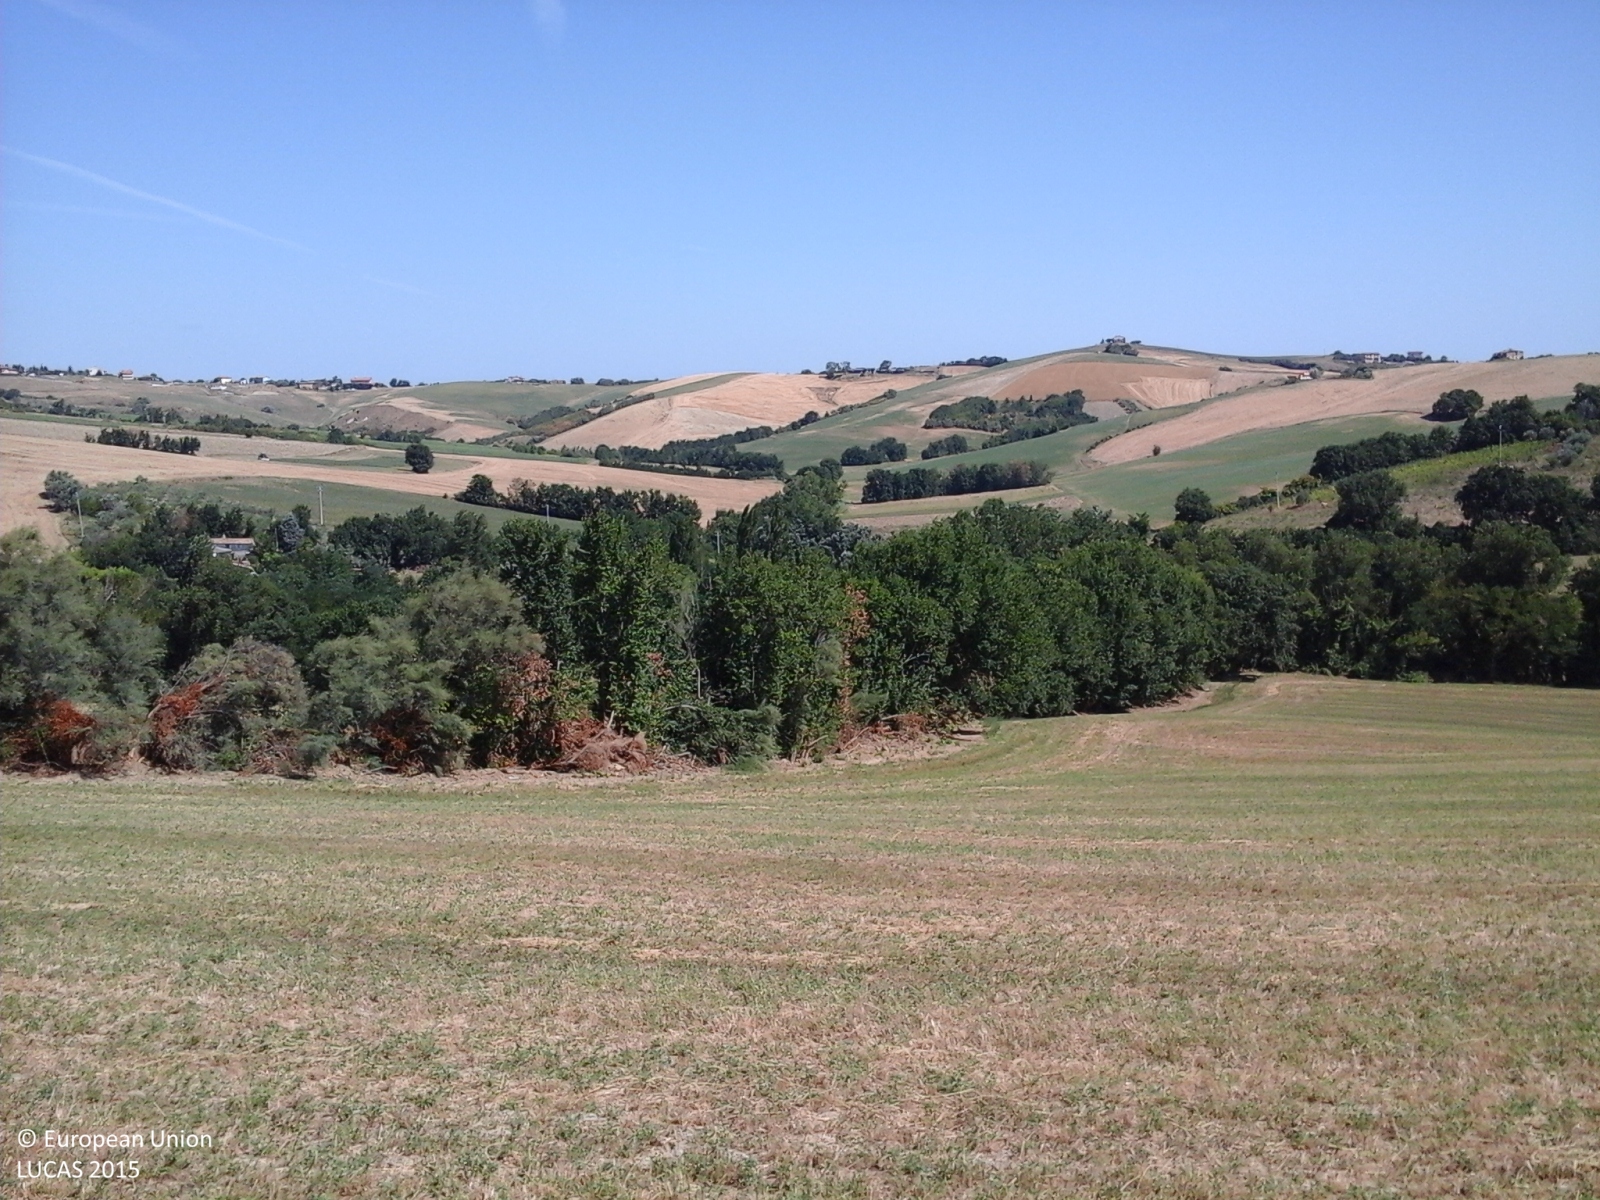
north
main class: Cropland
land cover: Lucerne
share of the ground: > 75 %
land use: Agriculture (excluding fallow land and kitchen gardens)
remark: Harvested field
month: July
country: IT
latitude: 43.8824
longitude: 12.6945
